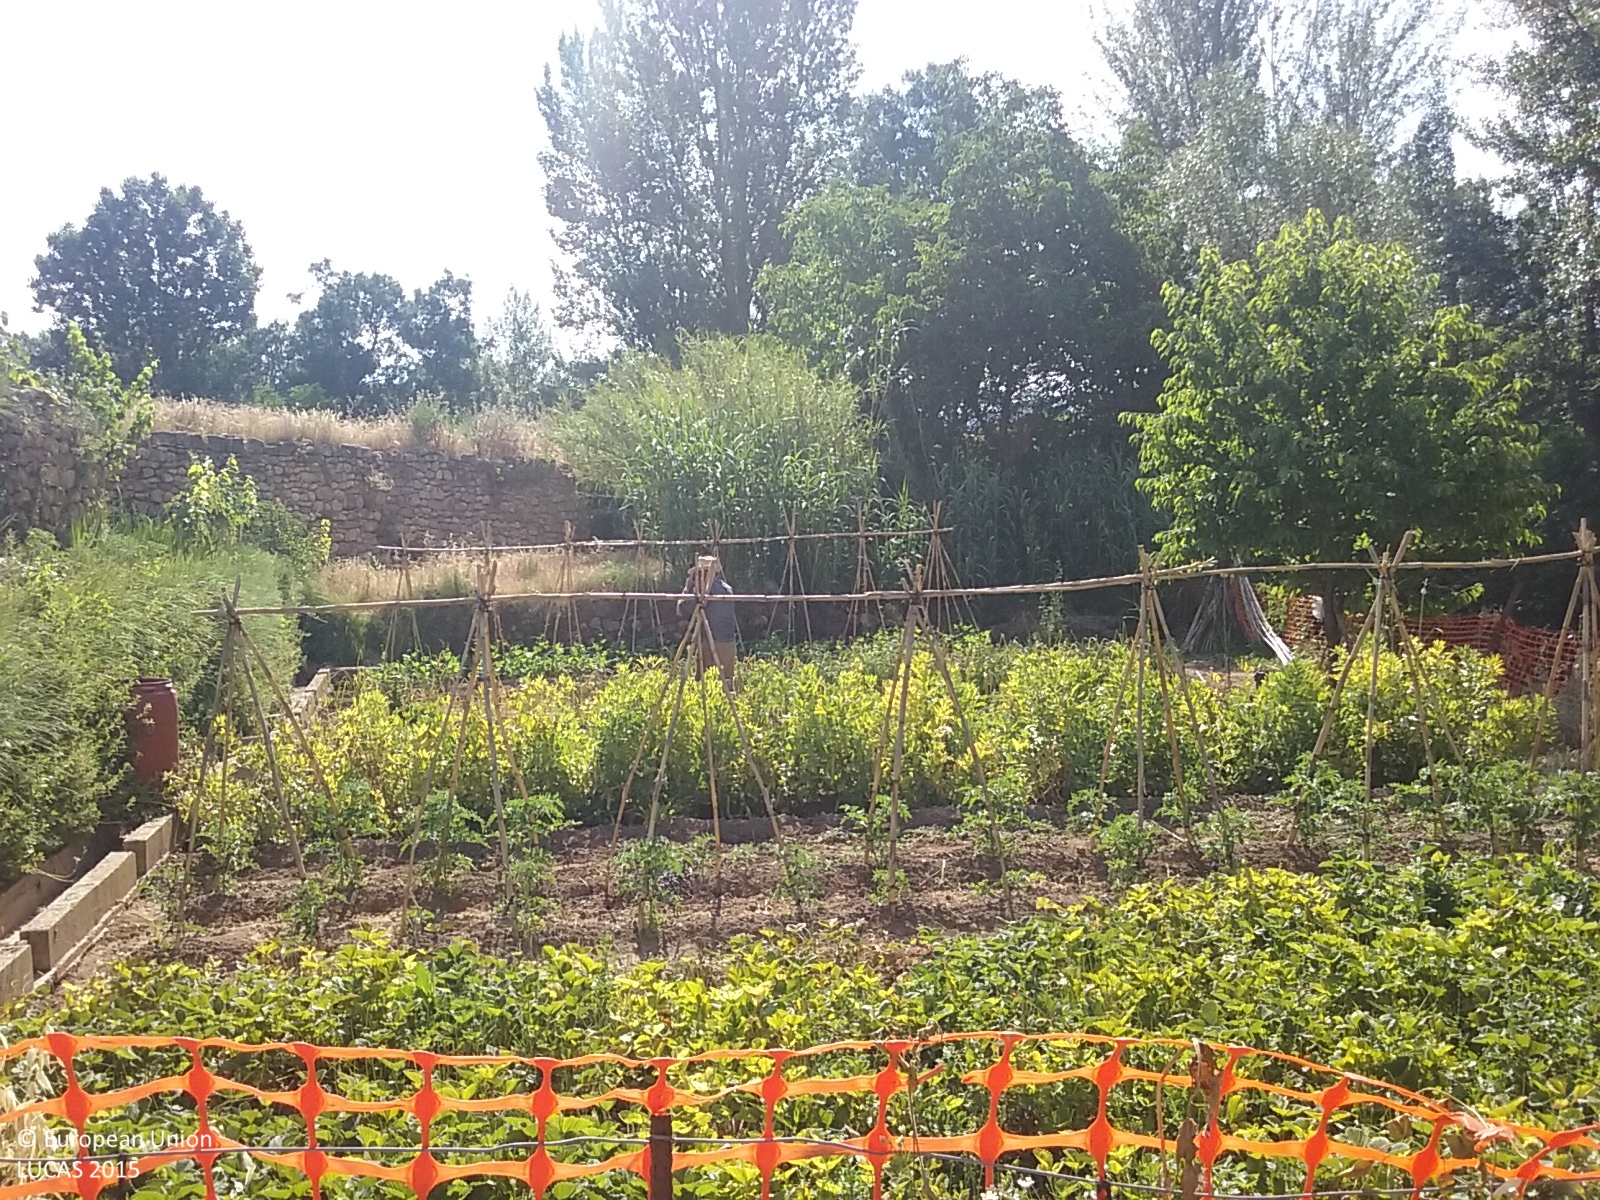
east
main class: Grassland
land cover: Spontaneously vegetated surfaces
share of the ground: > 75 %
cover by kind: herbaceous plants 100 %
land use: Abandoned areas
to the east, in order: Dry stone walls; Ditches and canals; Other fresh vegetables; Tracks; Grassland without tree/shrub cover; Dry stone walls; Artificial constructions in urban areas; Broadleaved woodland; Inland fresh running water; Broadleaved woodland; Nuts trees; Dry stone walls; Spontaneously vegetated surfaces; Dry stone walls; Tracks; Spontaneously vegetated surfaces
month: June
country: ES
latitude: 40.8637
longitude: 0.1564
